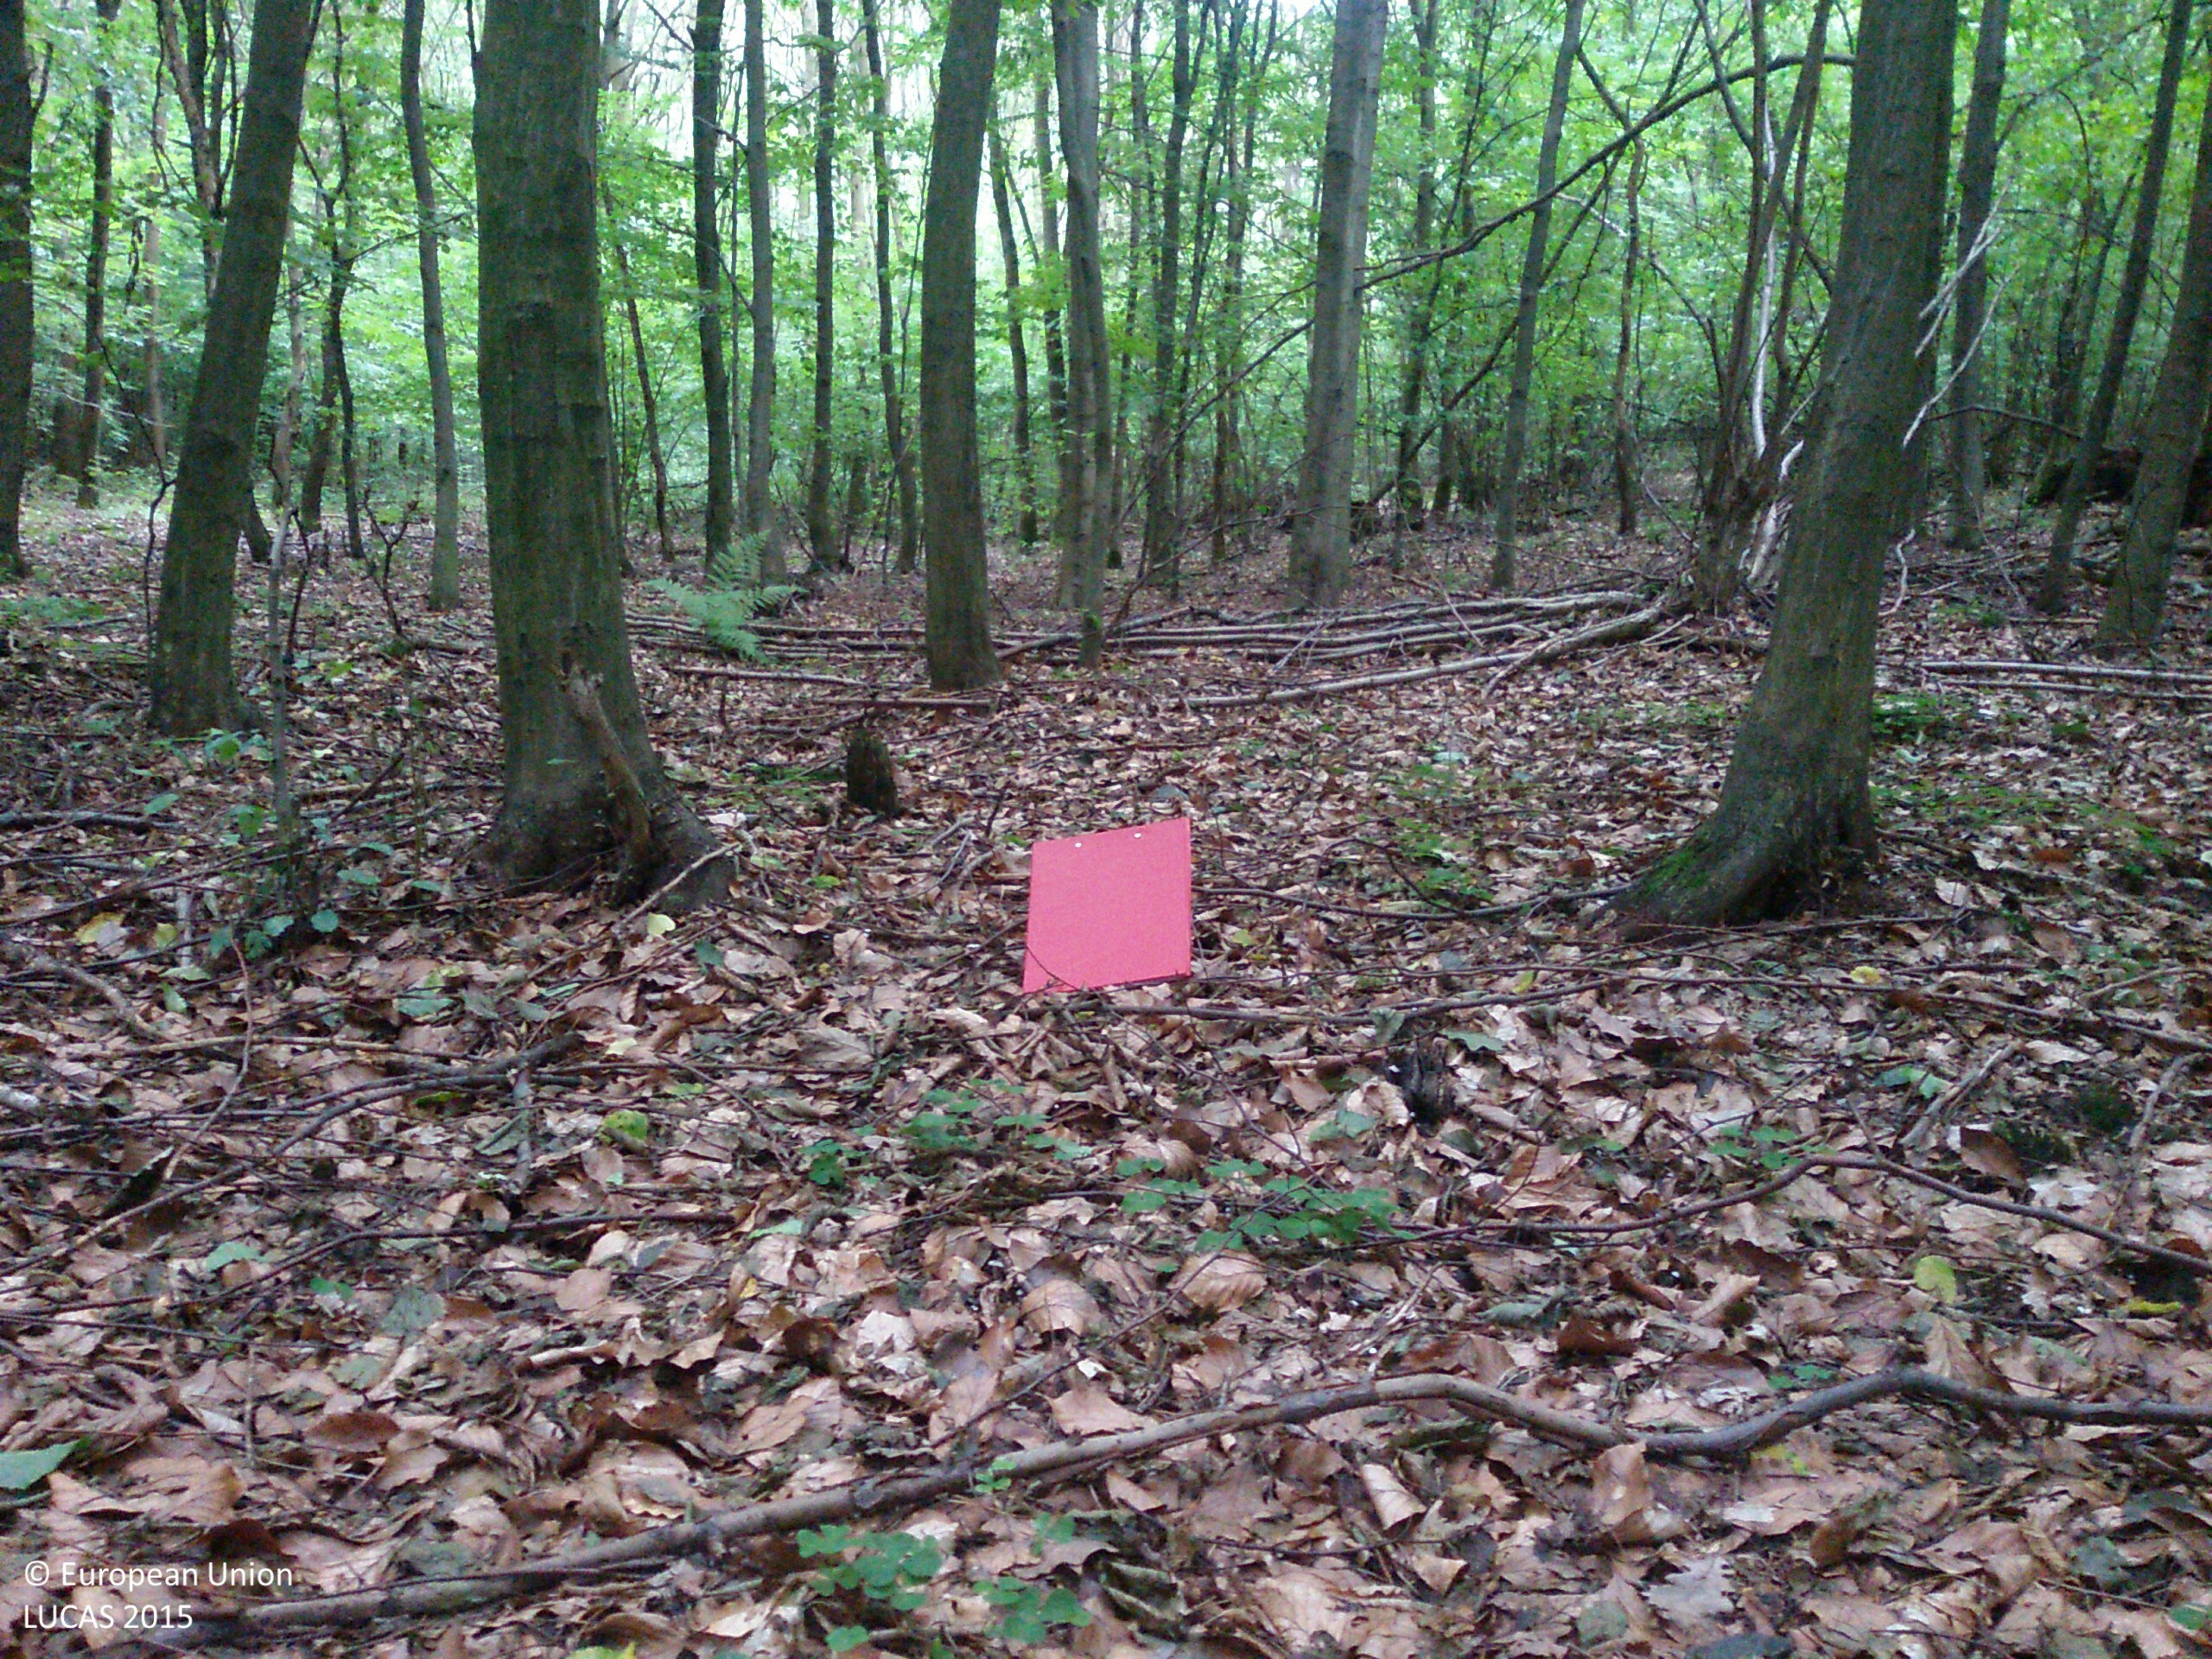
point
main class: Woodland
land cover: Broadleaved woodland
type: mesophytic deciduous forest
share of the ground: > 75 %
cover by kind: broadleaved forest trees 100 %
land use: Forestry
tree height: > 5 m
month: July
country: PL
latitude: 50.4315
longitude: 20.4124
